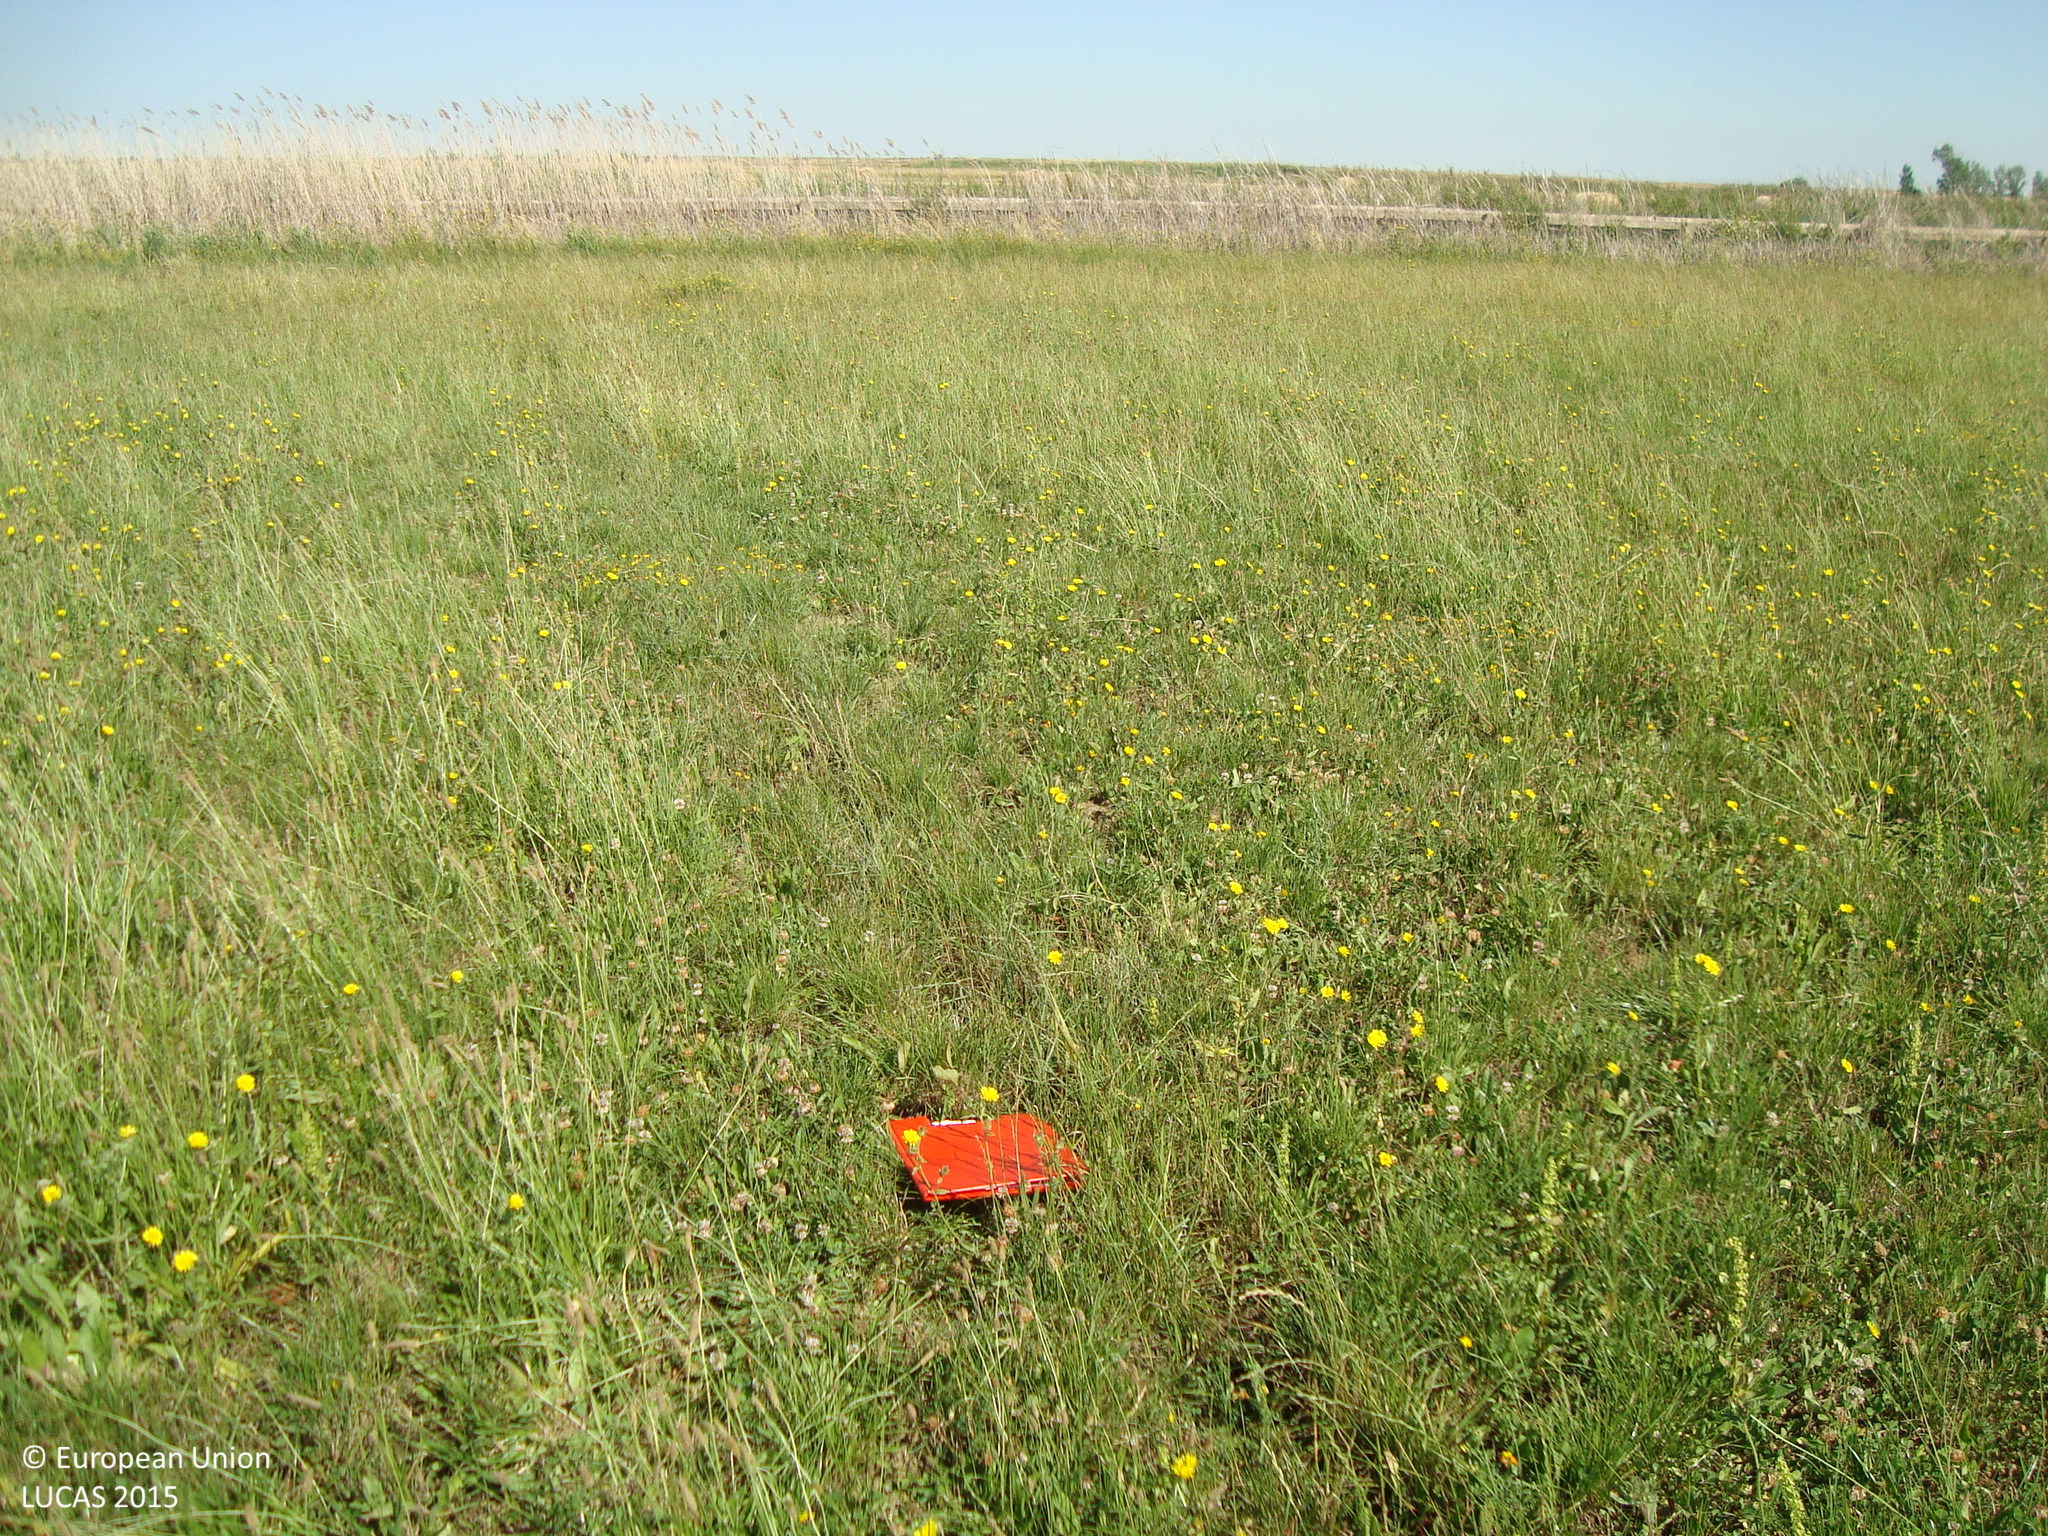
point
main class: Cropland
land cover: Other leguminous and mixtures for fodder
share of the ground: > 75 %
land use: Agriculture (excluding fallow land and kitchen gardens)
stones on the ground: > 50 %
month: July
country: ES
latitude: 42.0505
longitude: -4.7054
